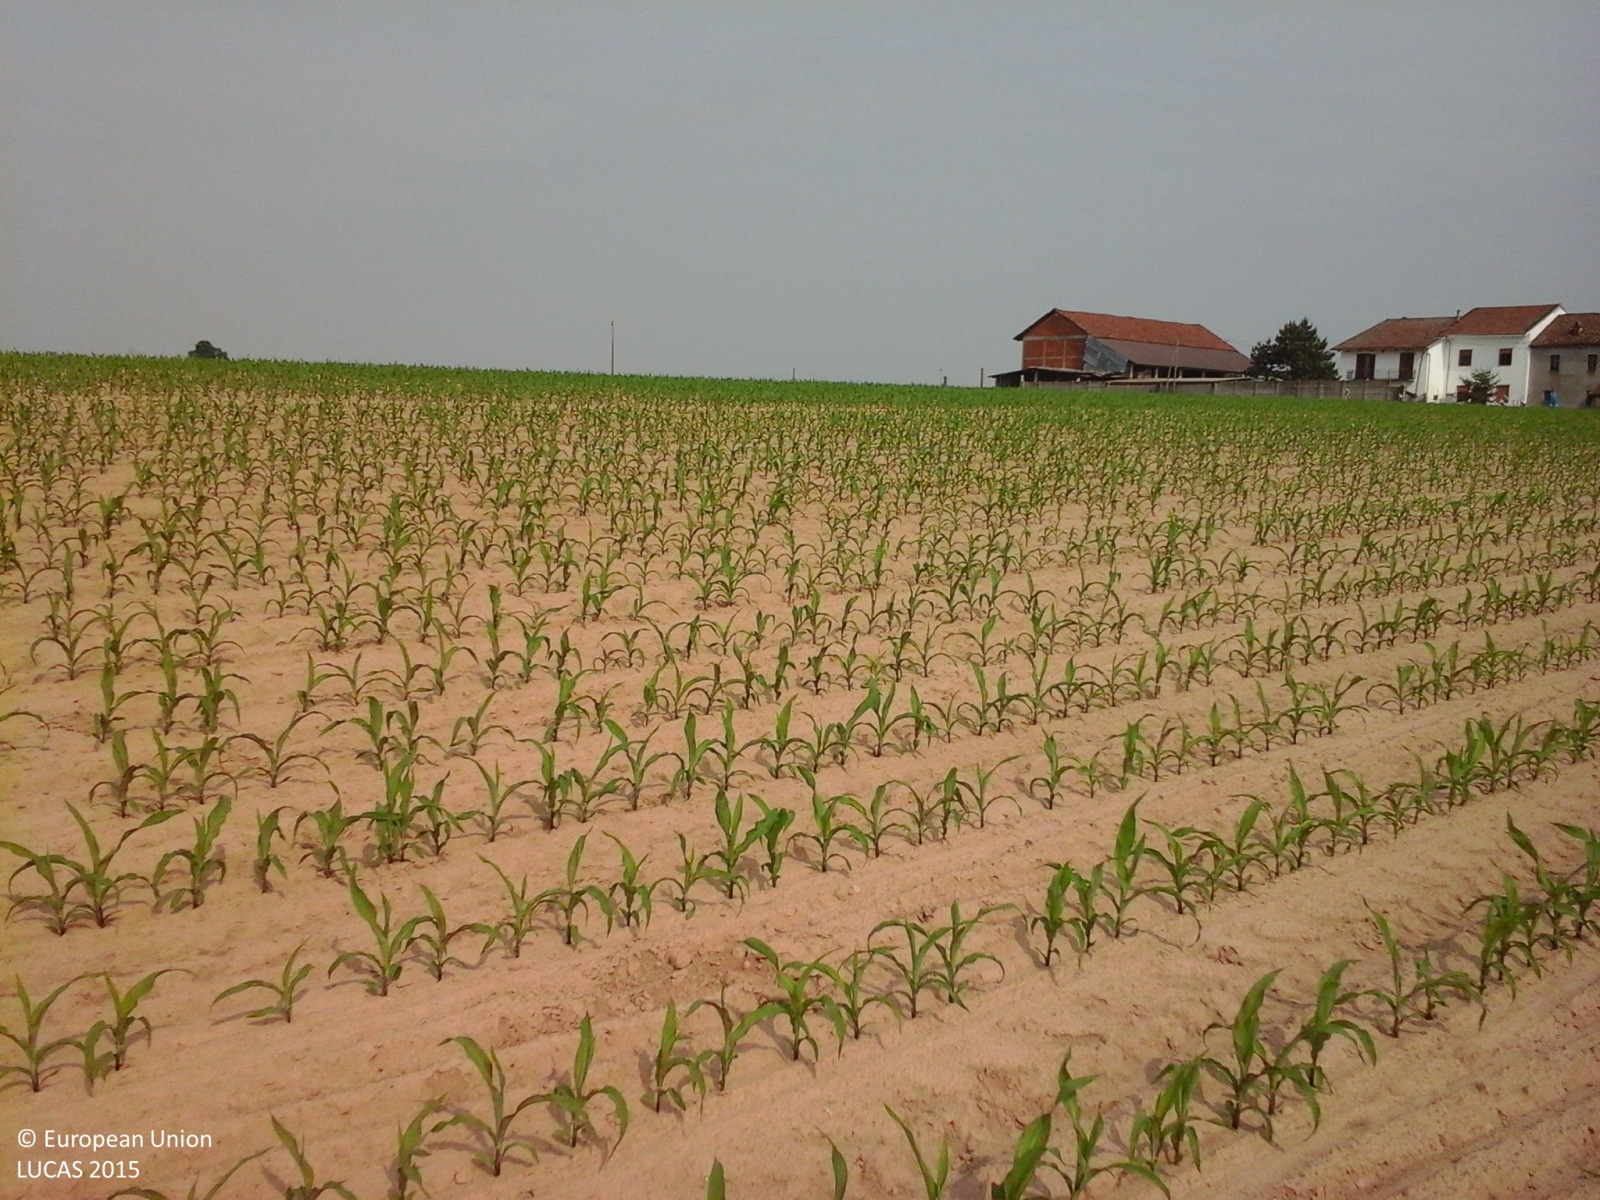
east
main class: Cropland
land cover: Maize
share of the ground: < 10 %
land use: Agriculture (excluding fallow land and kitchen gardens)
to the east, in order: Maize; Electric lines; Maize; Grass margins; Tracks; Grass margins; Ditches and canals; Common wheat
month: May
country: IT
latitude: 44.8316
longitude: 7.7654
